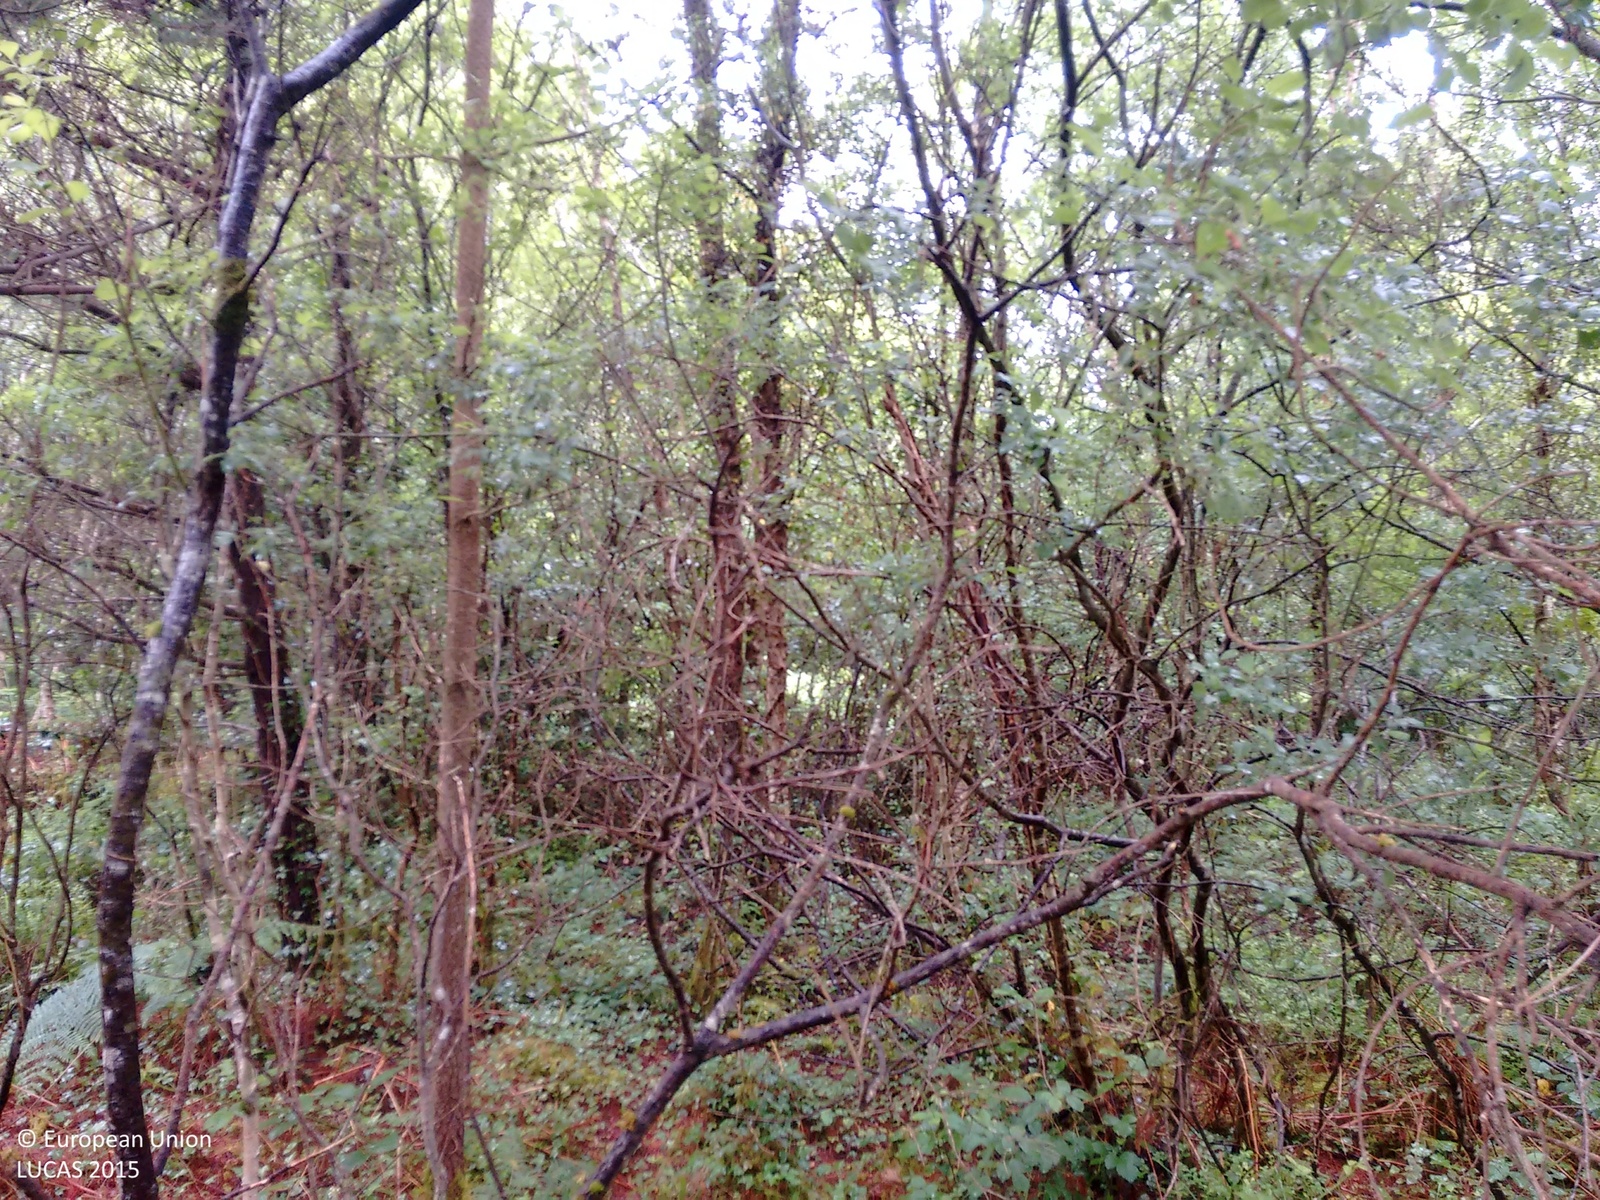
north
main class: Woodland
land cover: Pine dominated mixed woodland
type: exotic forest
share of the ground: > 75 %
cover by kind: coniferous forest trees 50 %, broadleaved forest trees 25 %, lichens and mosses 20 %, herbaceous plants 5 %
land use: Forestry
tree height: > 5 m
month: July
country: IE
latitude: 53.6274
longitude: -8.0966
